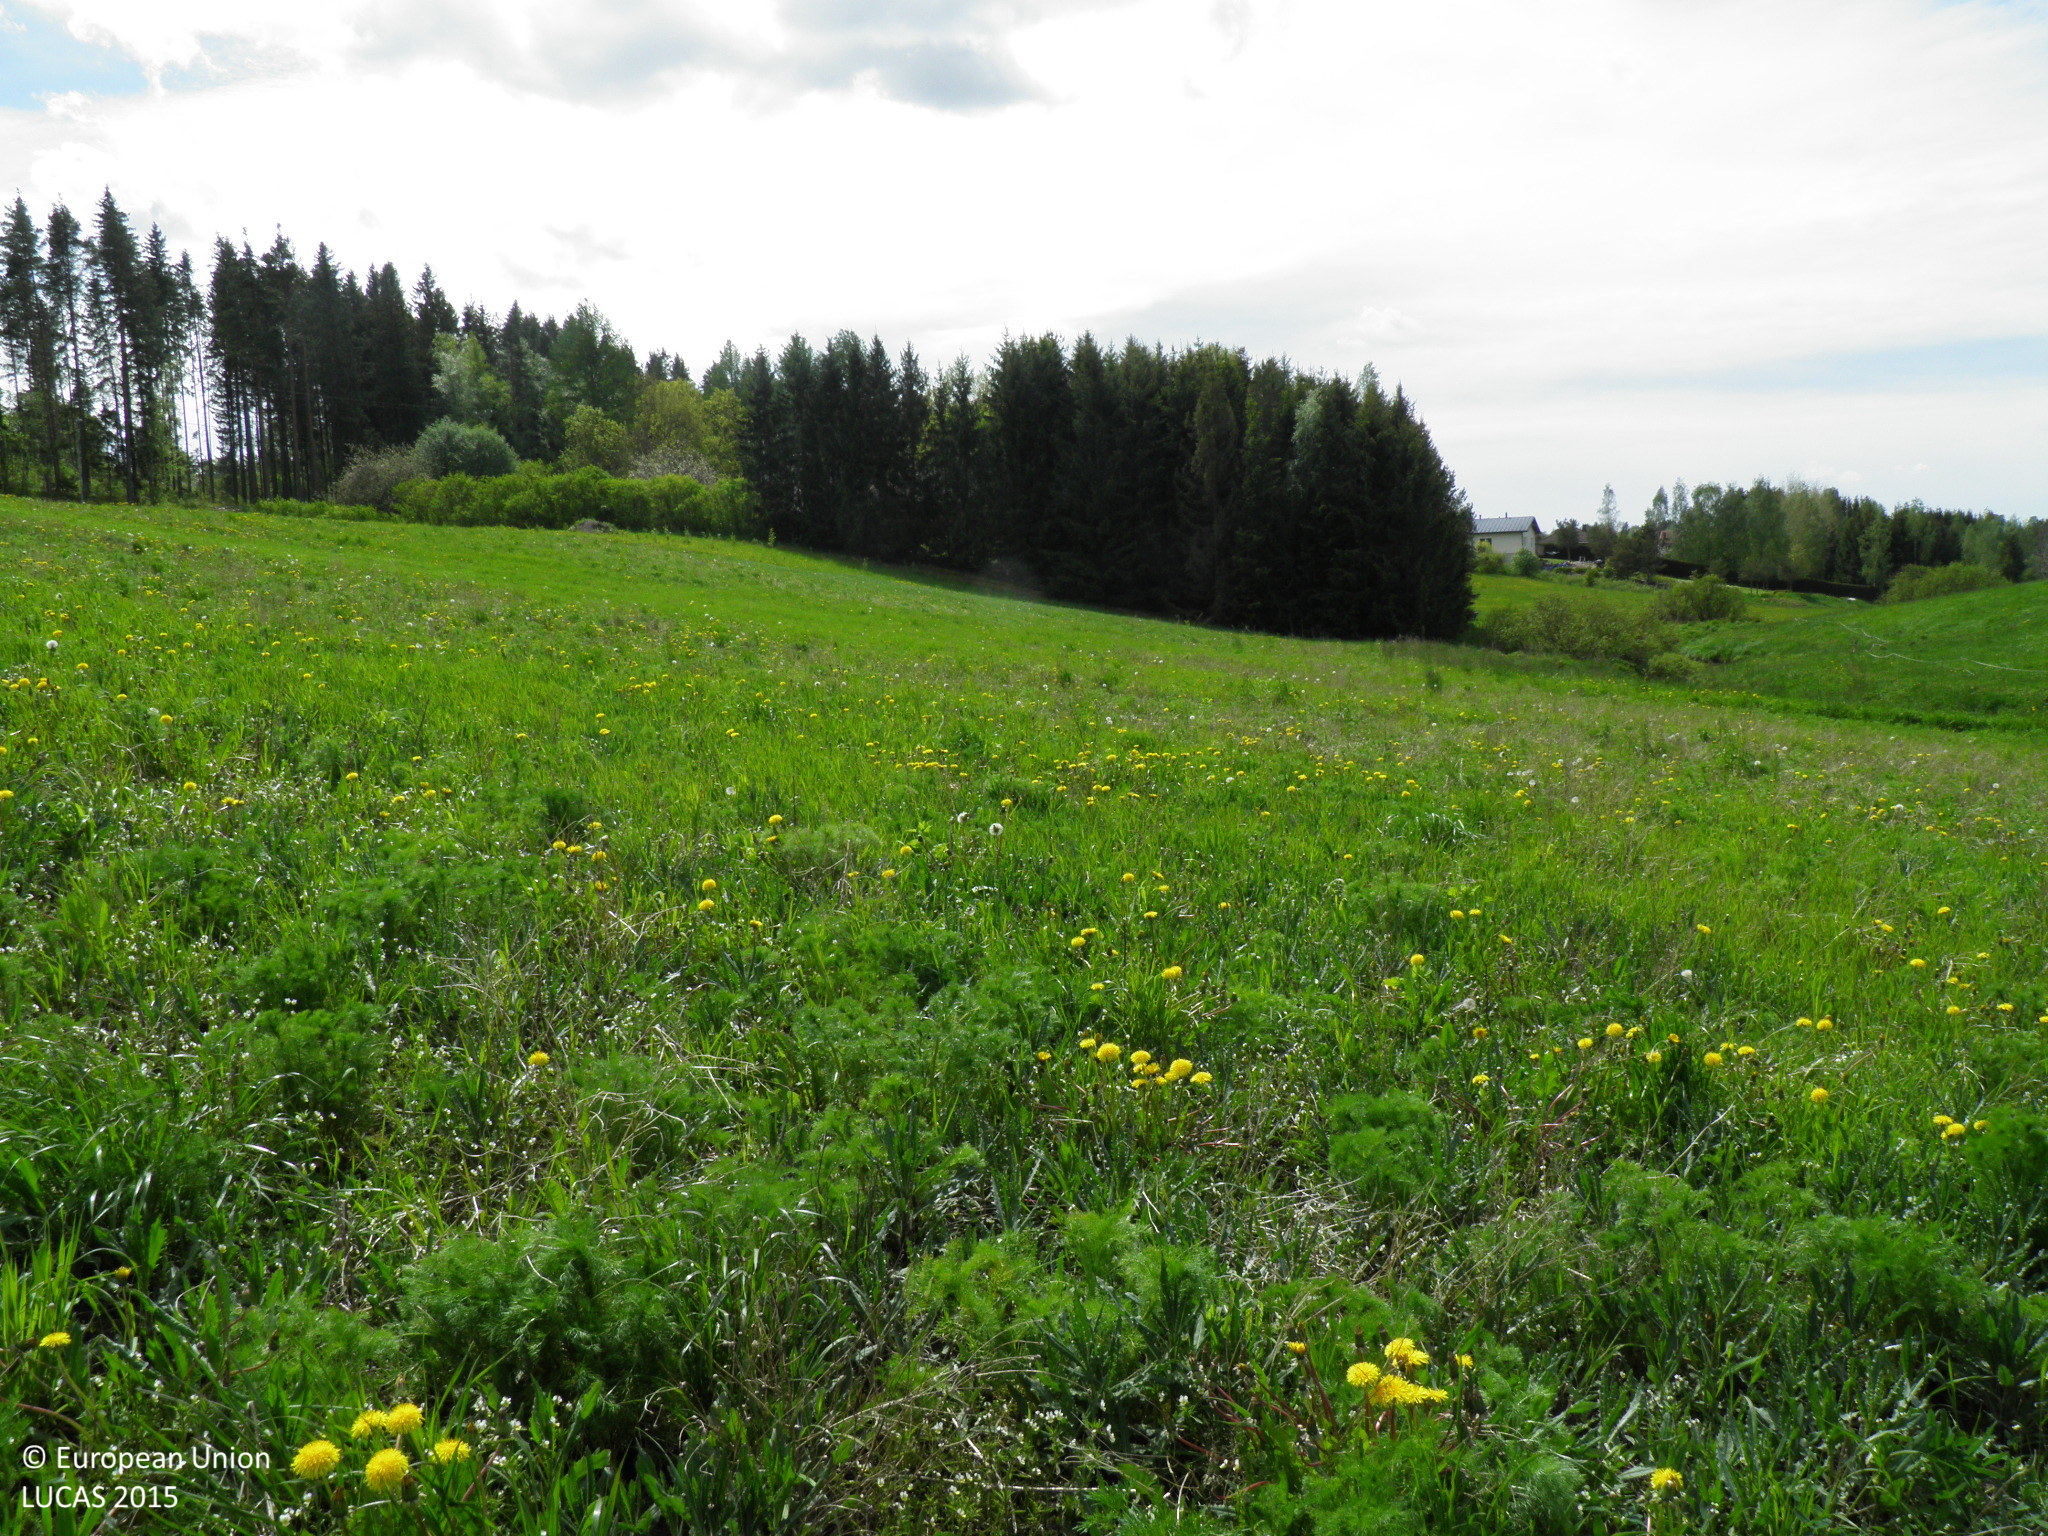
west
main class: Grassland
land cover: Grassland without tree/shrub cover
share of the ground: > 75 %
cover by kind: herbaceous plants 100 %
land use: Abandoned areas
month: June
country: FI
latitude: 60.4614
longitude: 22.7115
